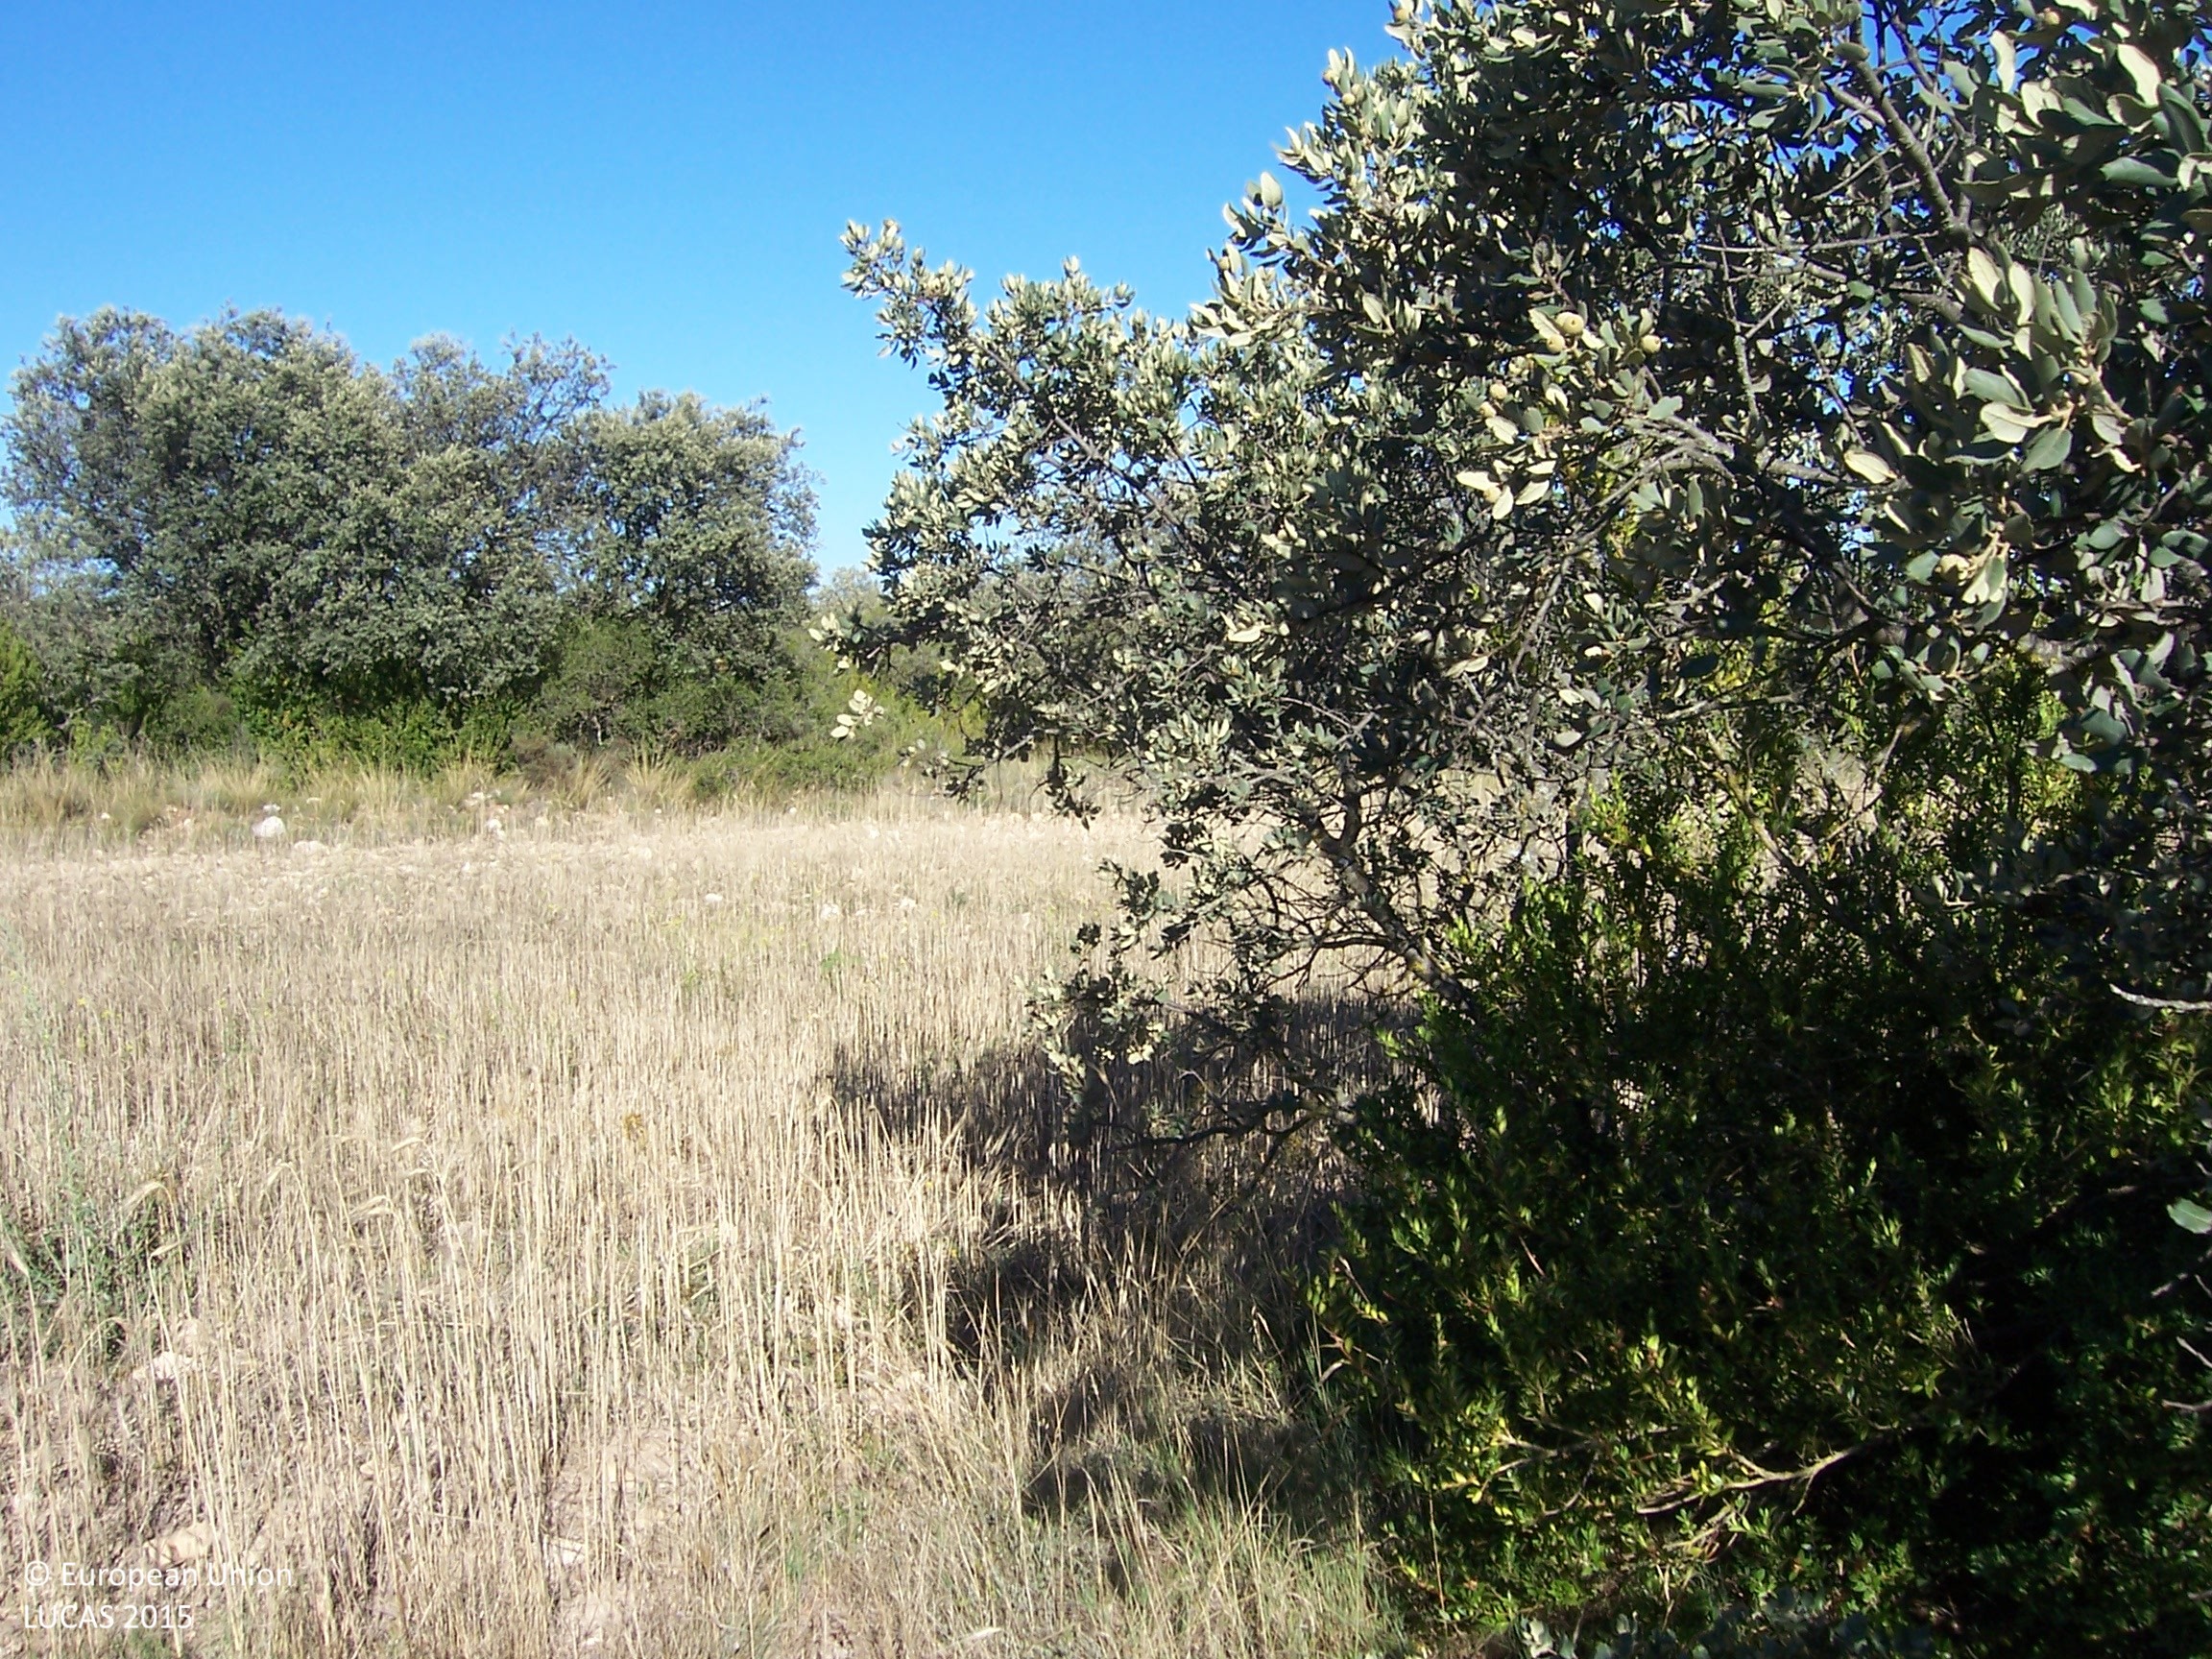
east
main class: Woodland
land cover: Broadleaved woodland
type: broadleaved evergreen forest
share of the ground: > 75 %
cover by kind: herbaceous plants 40 %, unconsolidated bare surface 30 %, broadleaved forest trees 20 %, shrubs 10 %
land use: Semi-natural and natural areas not in use
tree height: < 5 m
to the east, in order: Broadleaved woodland; Spontaneously vegetated surfaces; Broadleaved woodland; Shrubland with sparse tree cover; Grassland without tree/shrub cover; Broadleaved woodland; Common wheat
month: August
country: ES
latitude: 42.0072
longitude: 0.5058
